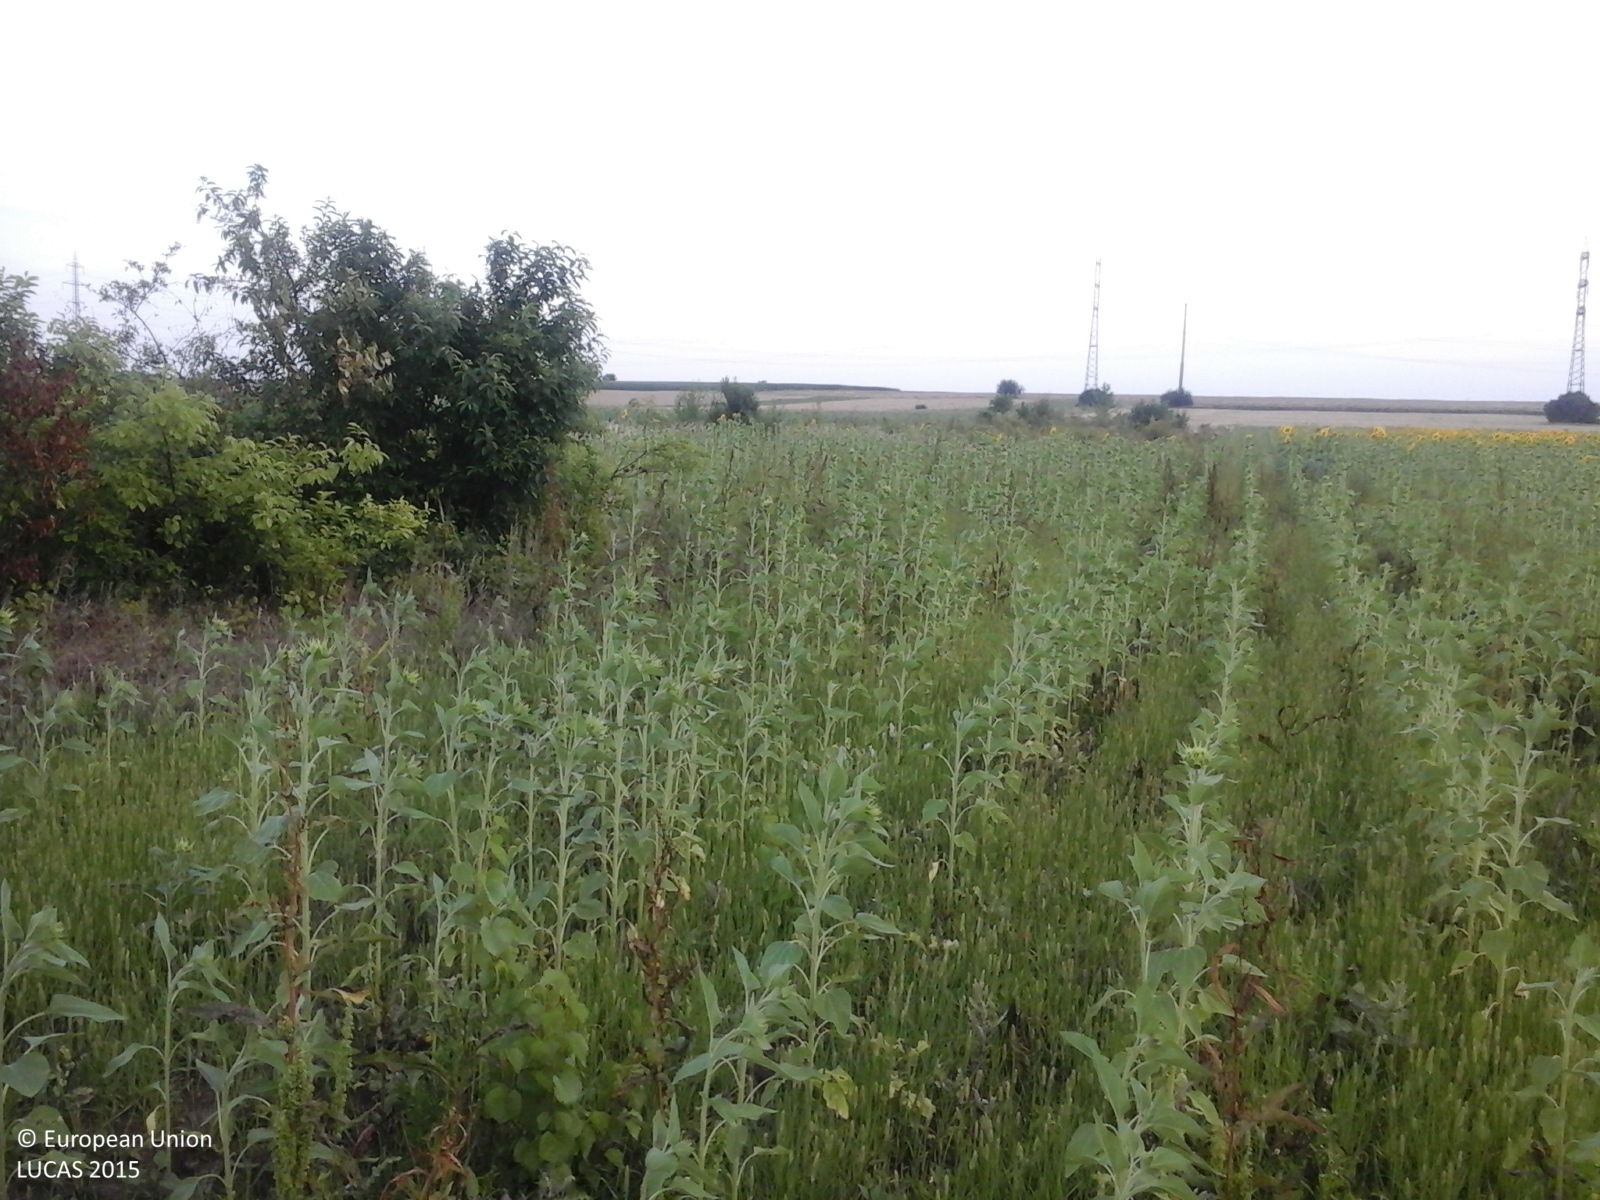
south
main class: Cropland
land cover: Sunflower
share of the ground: 50 - 75 %
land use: Agriculture (excluding fallow land and kitchen gardens)
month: July
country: RO
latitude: 43.9597
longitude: 25.2987
